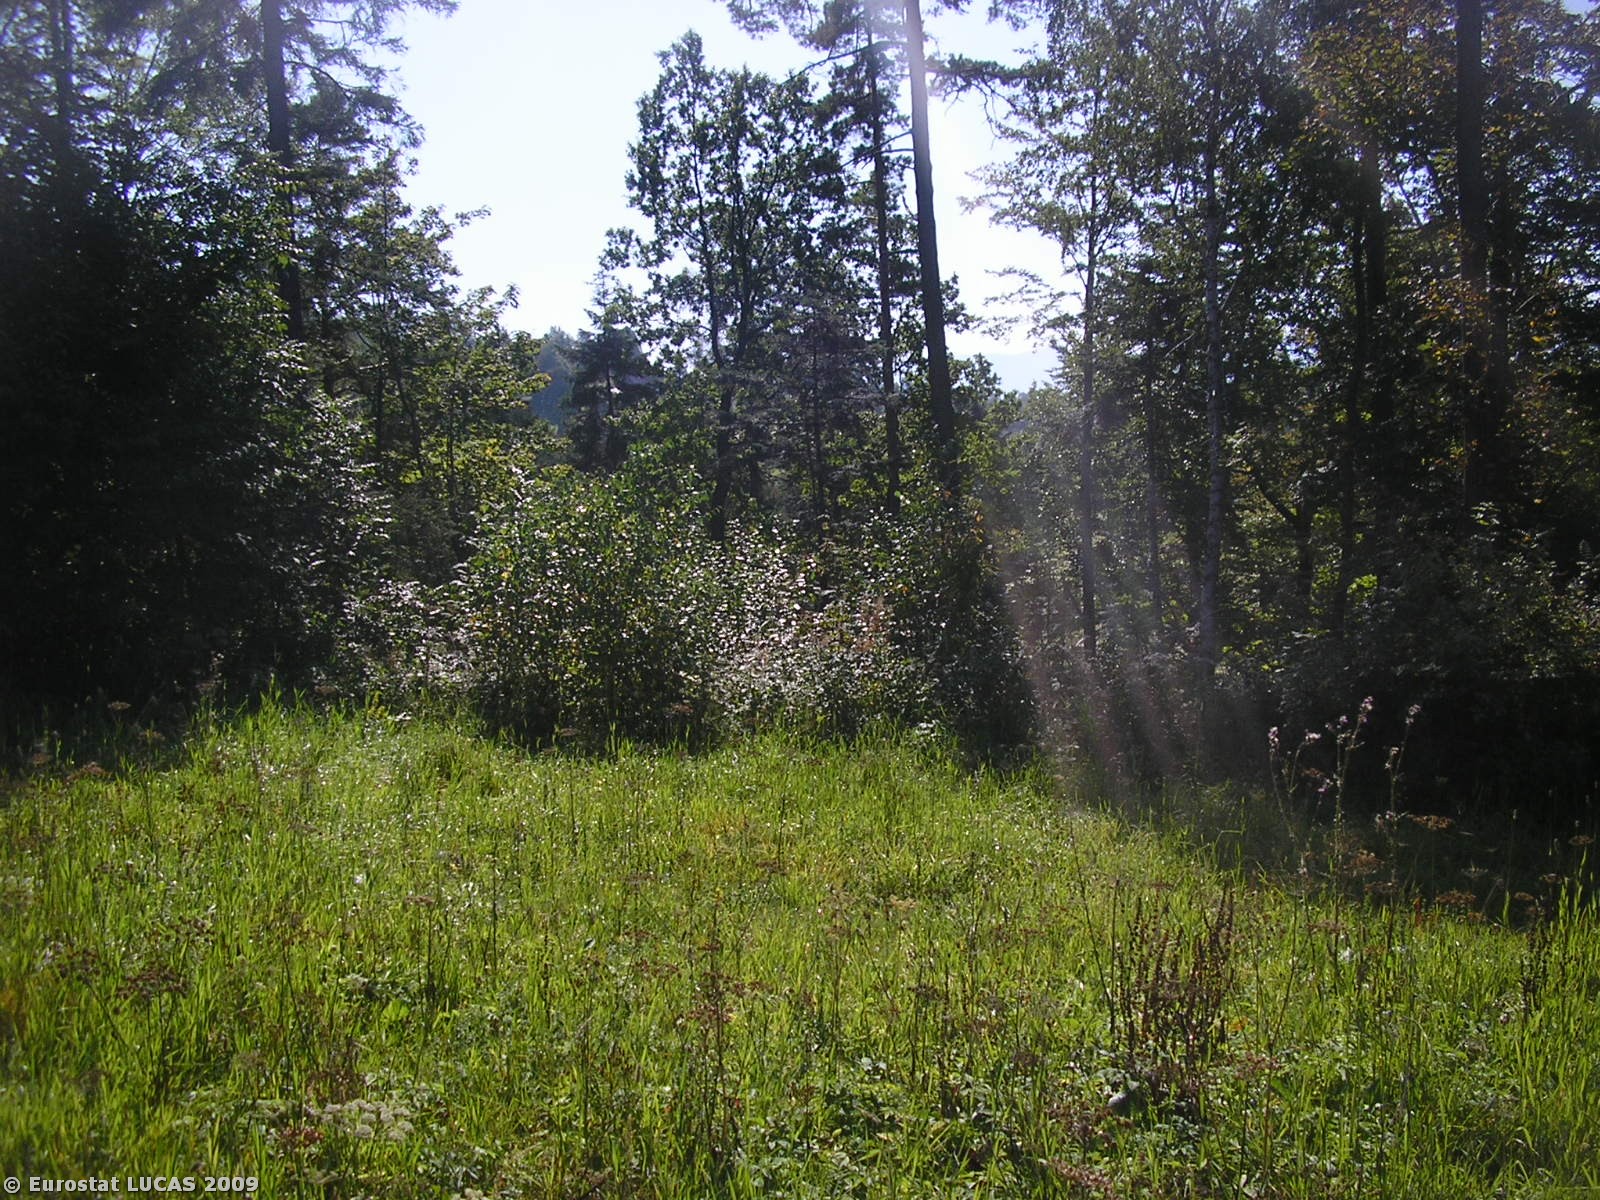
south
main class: Grassland
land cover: Grassland without tree/shrub cover
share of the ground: > 75 %
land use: Agriculture (excluding fallow land and kitchen gardens)
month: September
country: PL
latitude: 49.7537
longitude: 19.6753
